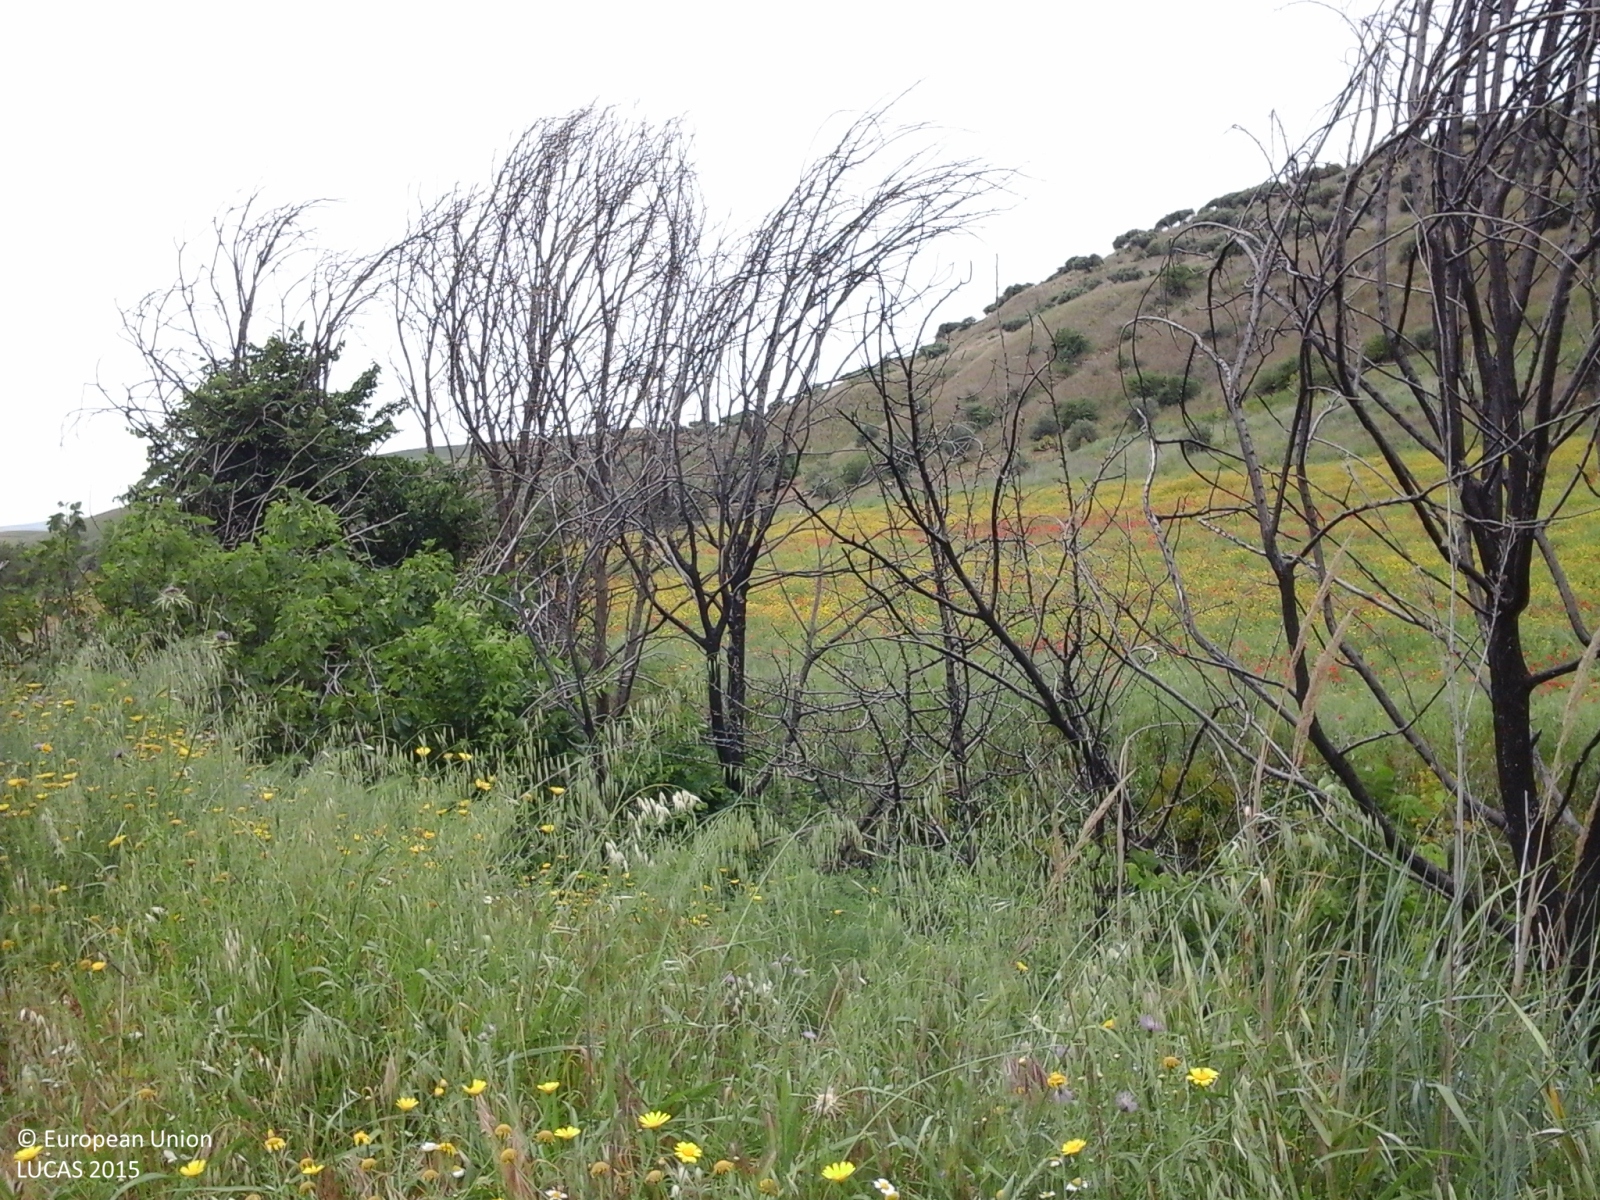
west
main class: Grassland
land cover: Spontaneously vegetated surfaces
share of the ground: > 75 %
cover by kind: herbaceous plants 100 %
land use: Agriculture (excluding fallow land and kitchen gardens)
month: May
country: IT
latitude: 37.6645
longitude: 13.9727
